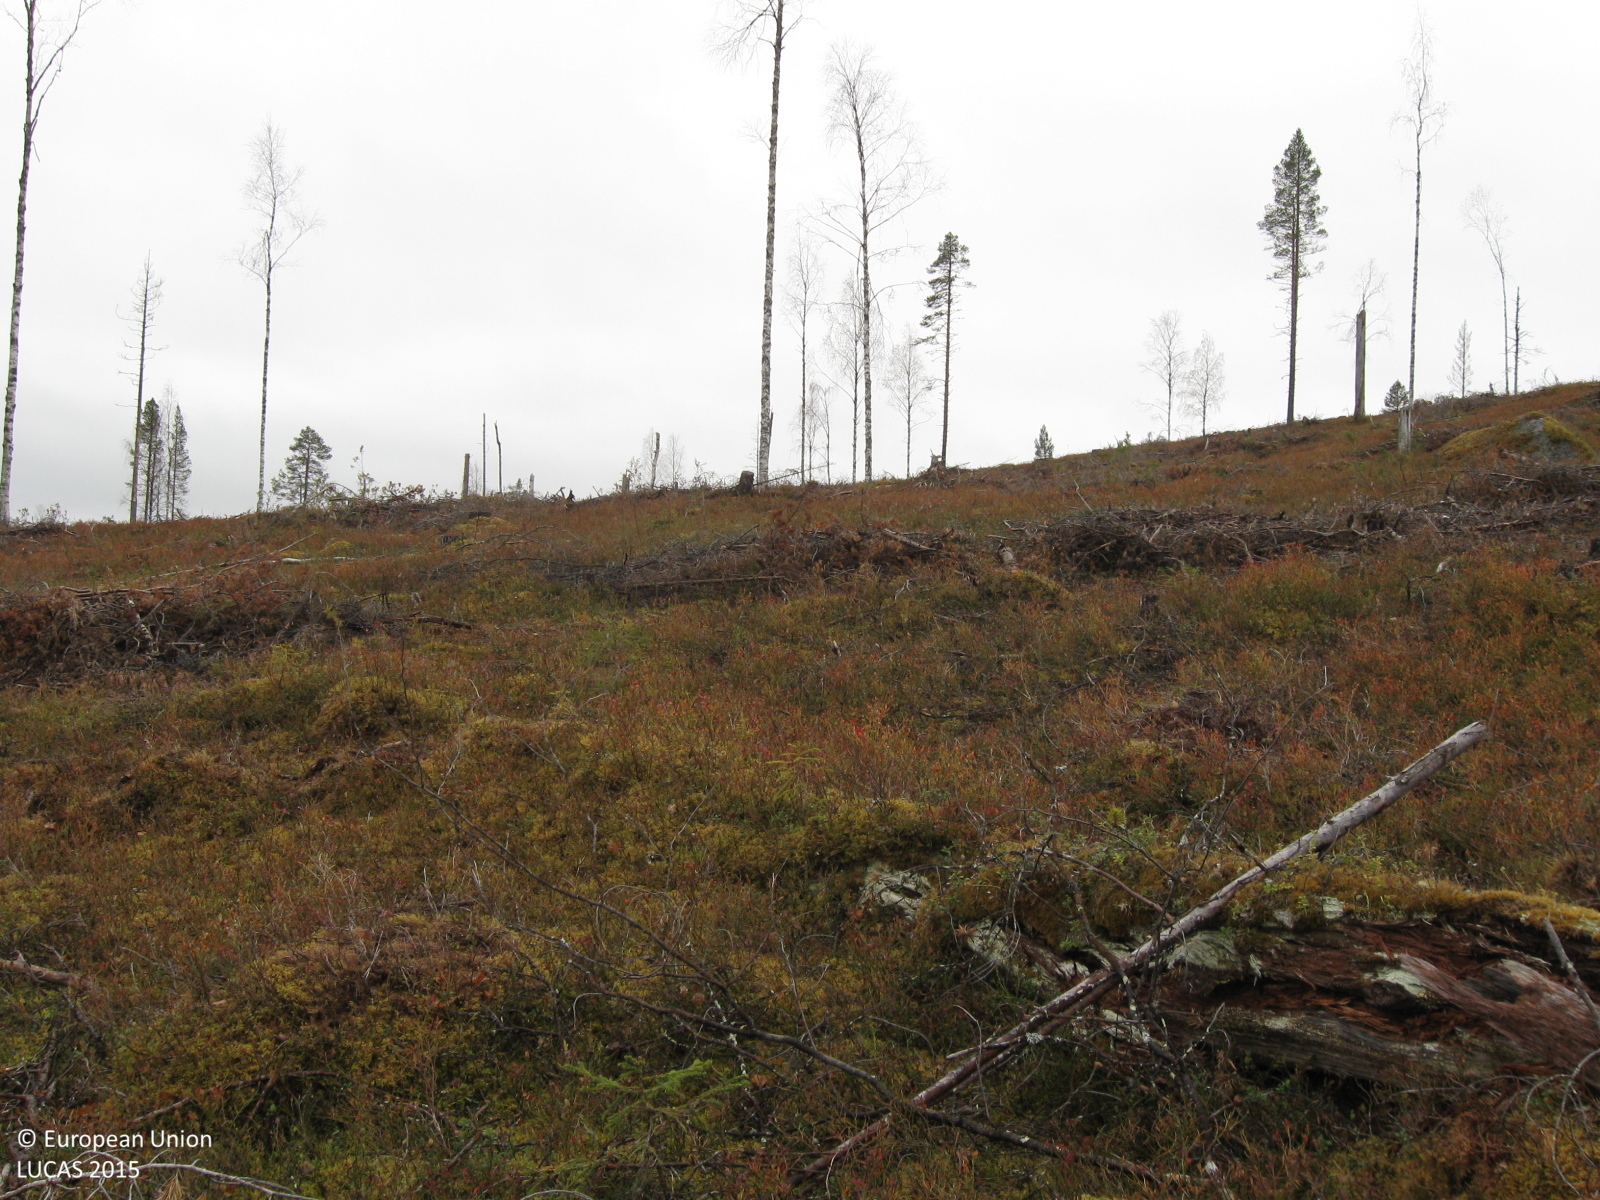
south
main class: Shrubland
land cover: Shrubland with sparse tree cover
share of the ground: 50 - 75 %
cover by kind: shrubs 65 %, lichens and mosses 15 %, herbaceous plants 10 %, coniferous forest trees 5 %
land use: Forestry
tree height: < 5 m
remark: Clear cut
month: October
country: SE
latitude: 66.7165
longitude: 21.6364
